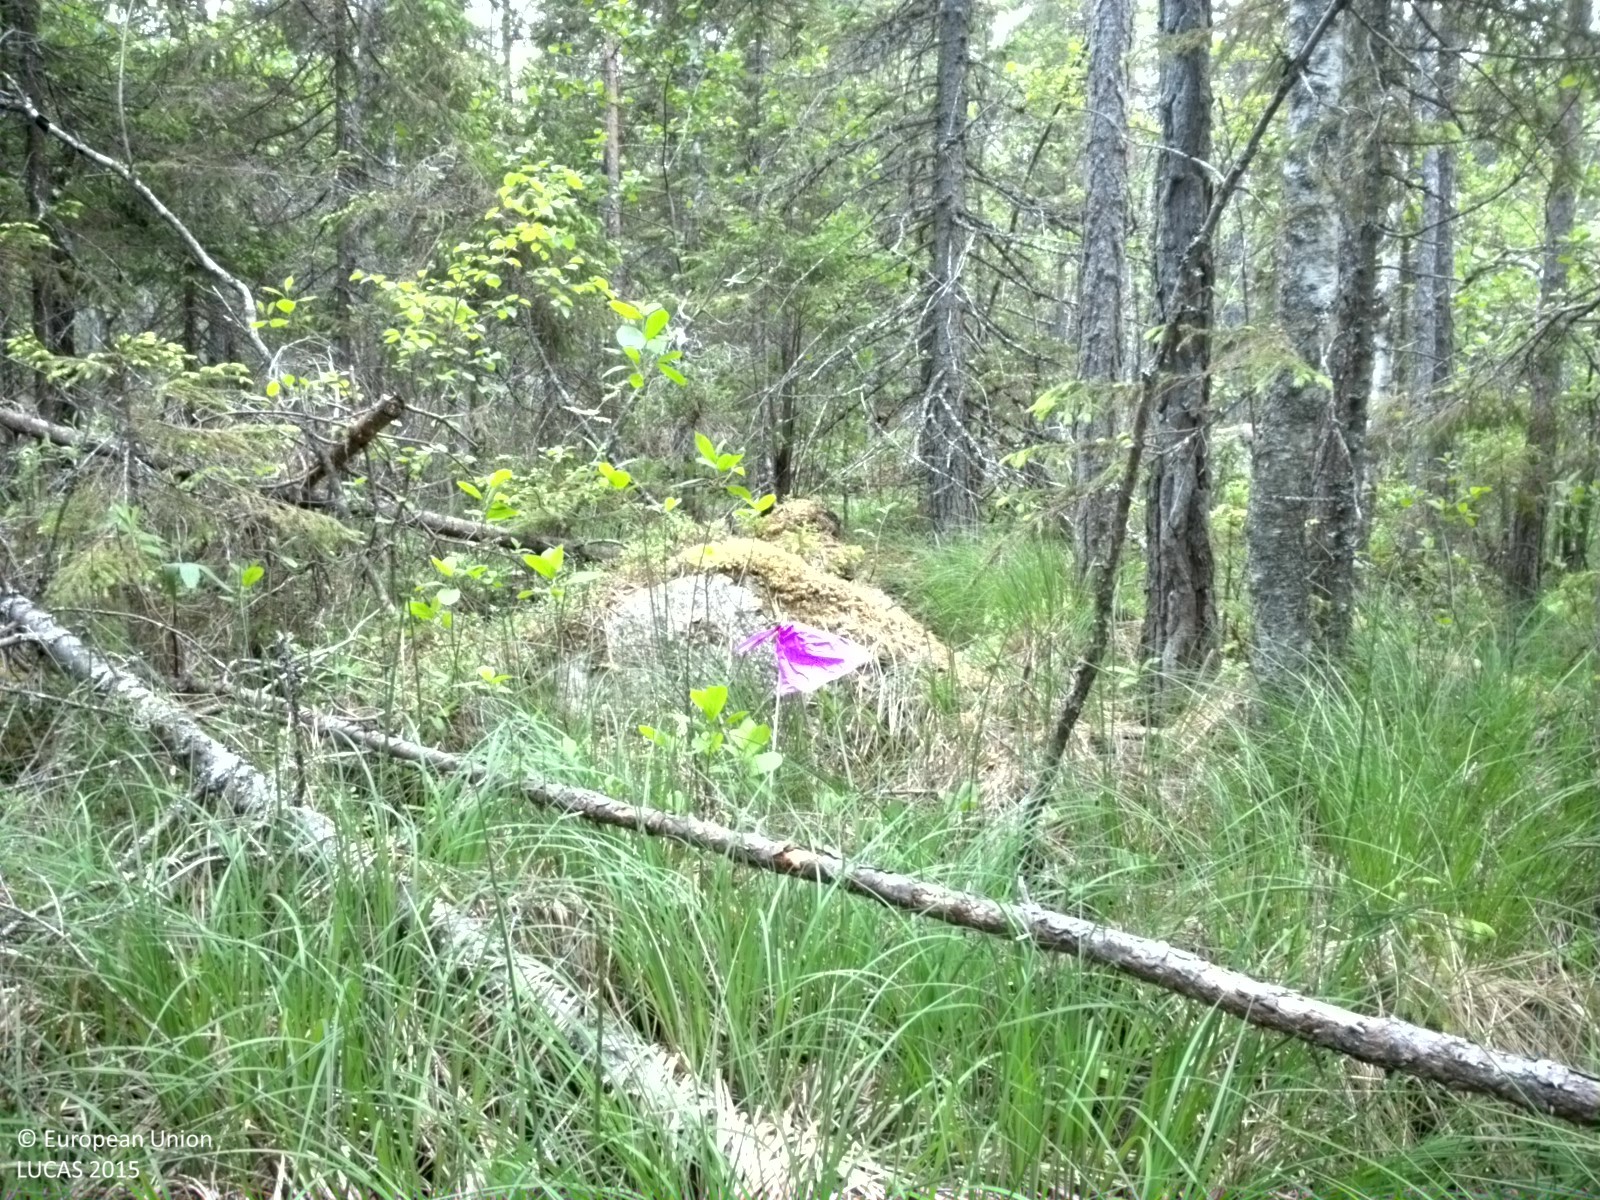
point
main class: Woodland
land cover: Other mixed woodland
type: boreal forest
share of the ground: 50 - 75 %
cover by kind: broadleaved forest trees 35 %, herbaceous plants 30 %, coniferous forest trees 25 %, lichens and mosses 5 %, consolidated bare surface 5 %
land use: Semi-natural and natural areas not in use
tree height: > 5 m
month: June
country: SE
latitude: 60.2692
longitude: 17.8569
